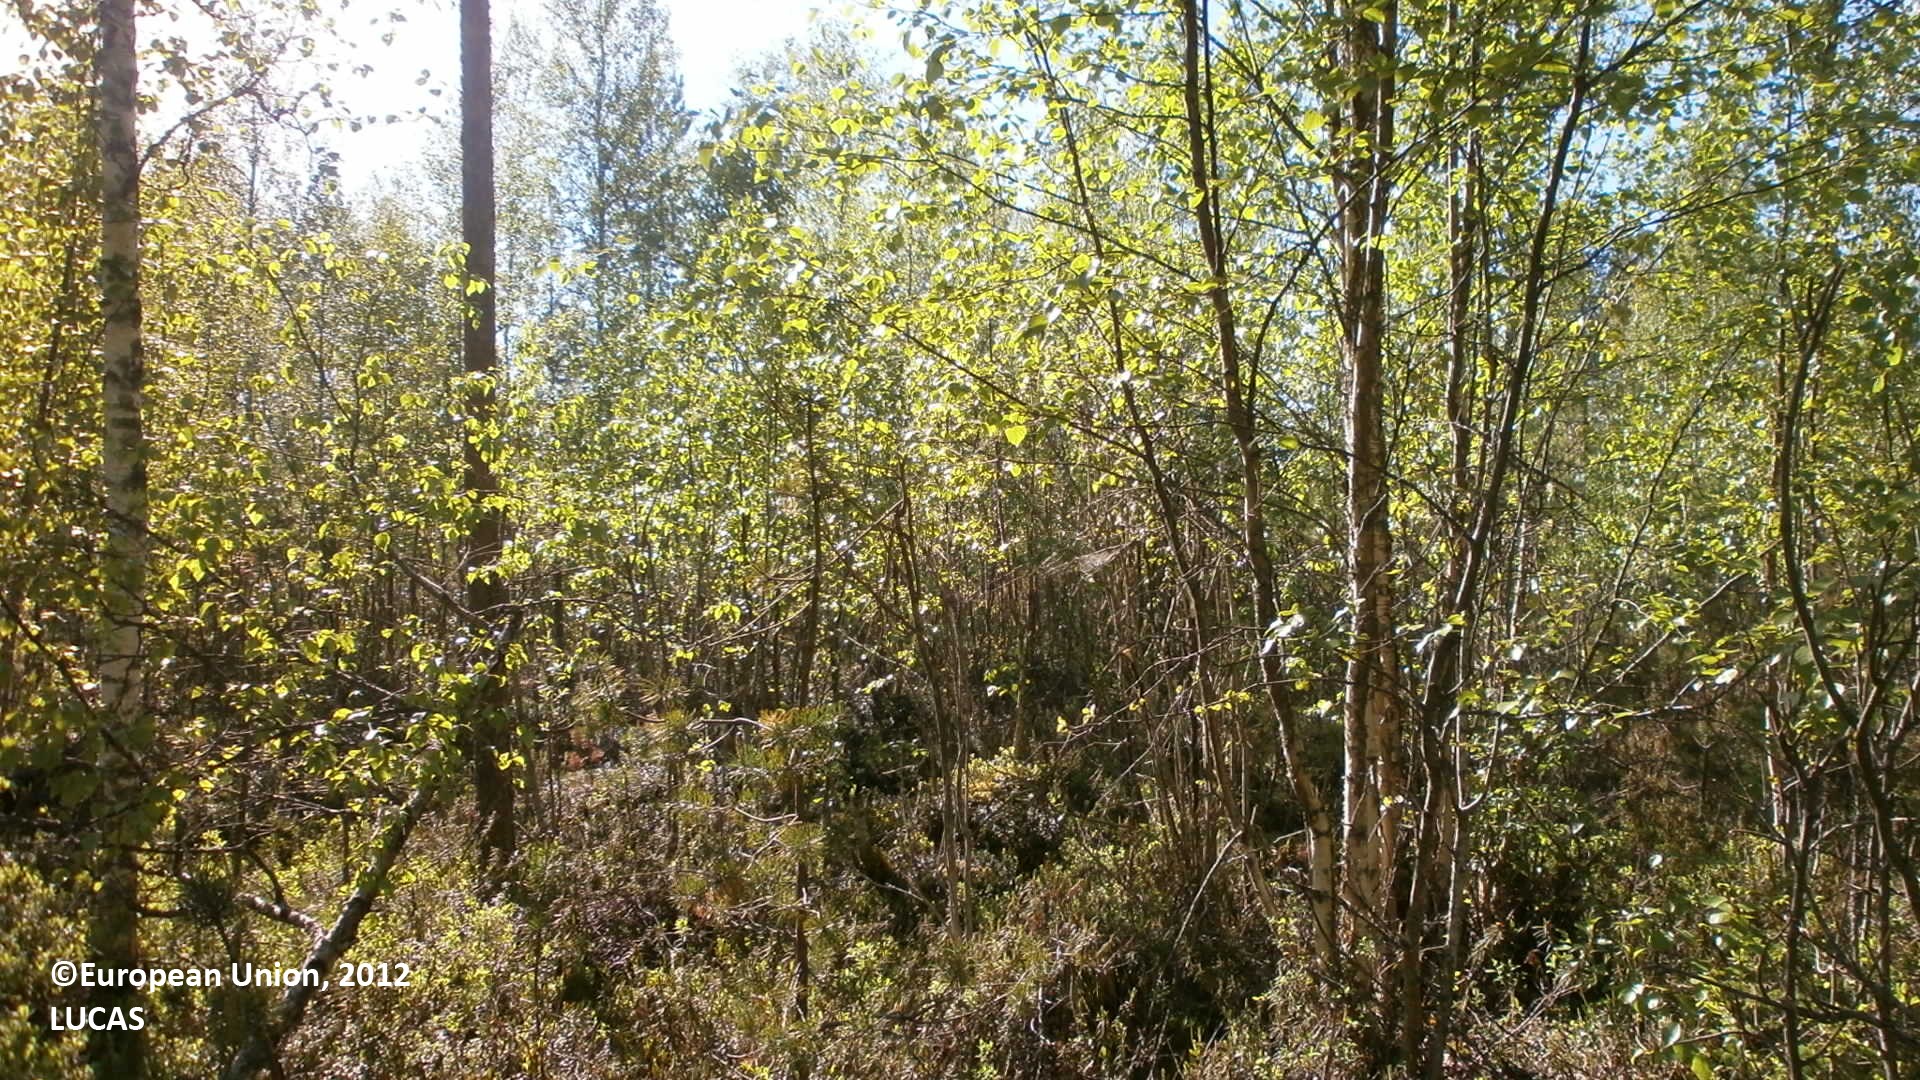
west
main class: Woodland
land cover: Broadleaved woodland
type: mire and swamp forests
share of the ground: 50 - 75 %
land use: Forestry
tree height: > 5 m
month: June
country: FI
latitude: 64.1379
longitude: 25.7782
